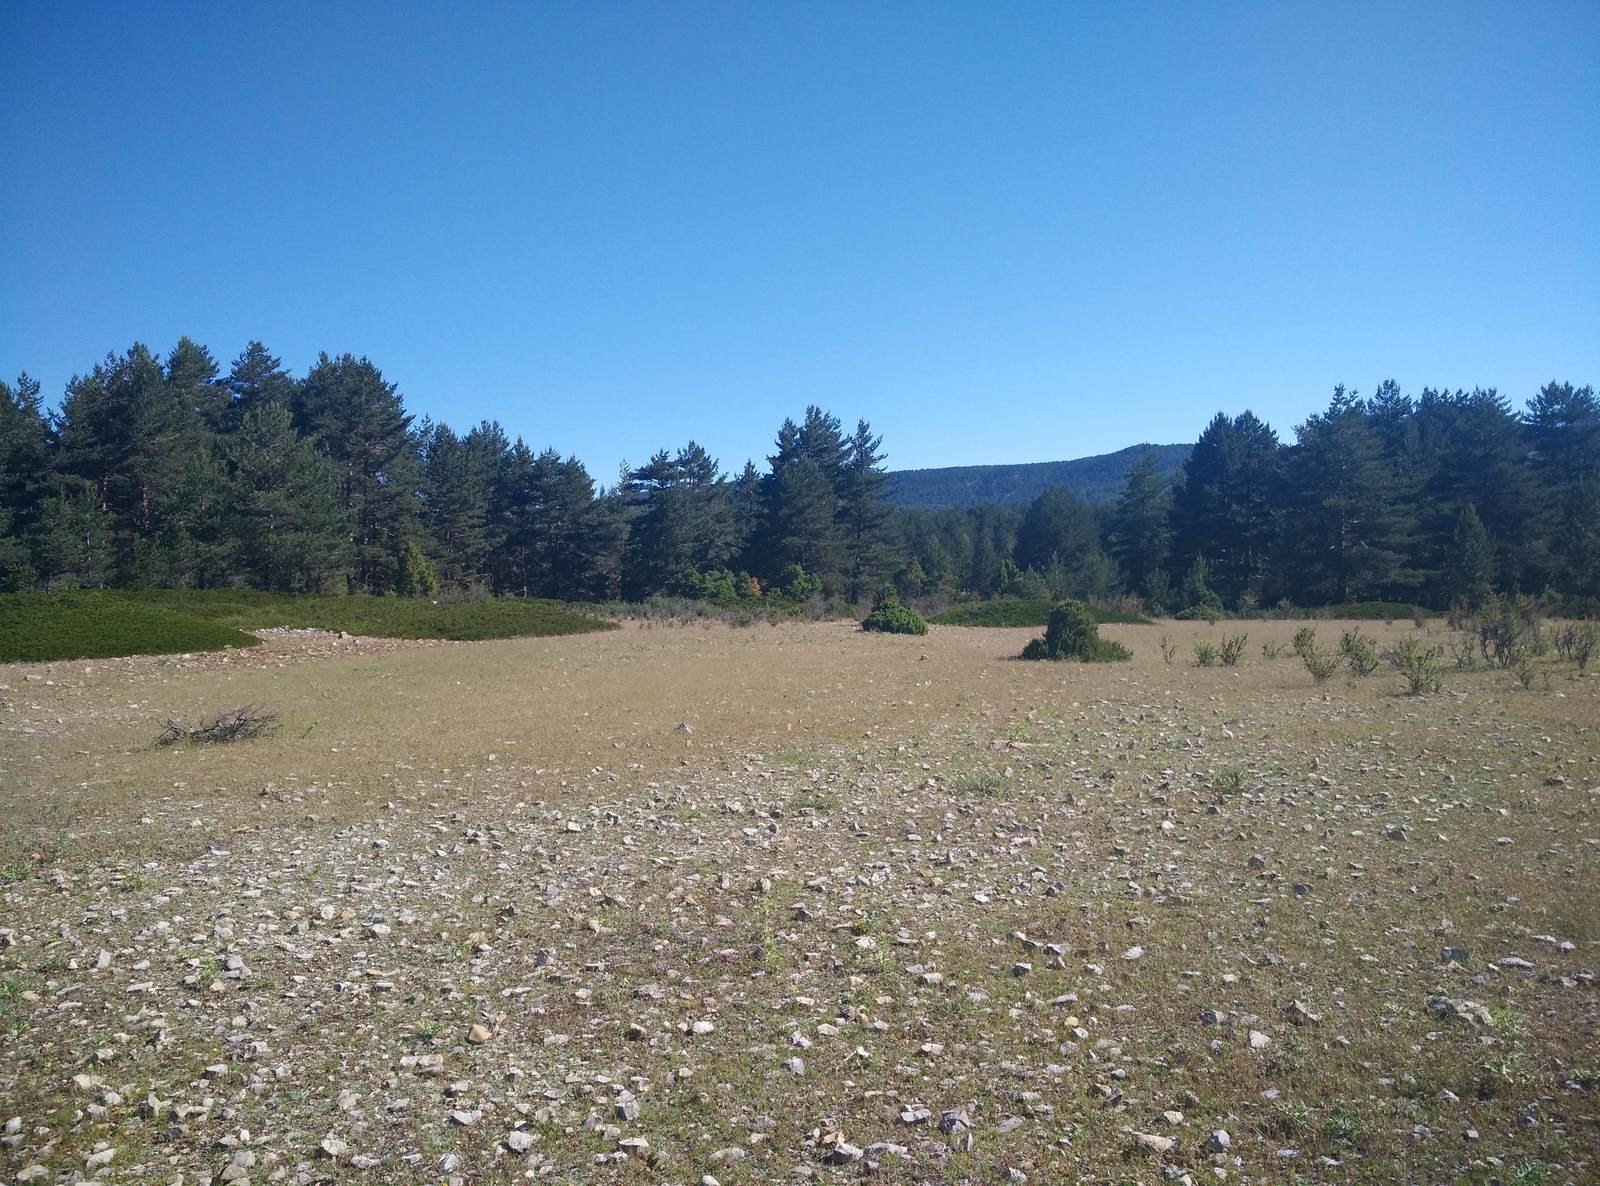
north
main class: Grassland
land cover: Grassland without tree/shrub cover
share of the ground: 50 - 75 %
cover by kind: herbaceous plants 70 %, consolidated bare surface 25 %, unconsolidated bare surface 5 %
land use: Agriculture (excluding fallow land and kitchen gardens)
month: June
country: ES
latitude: 40.3821
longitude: -1.7361
